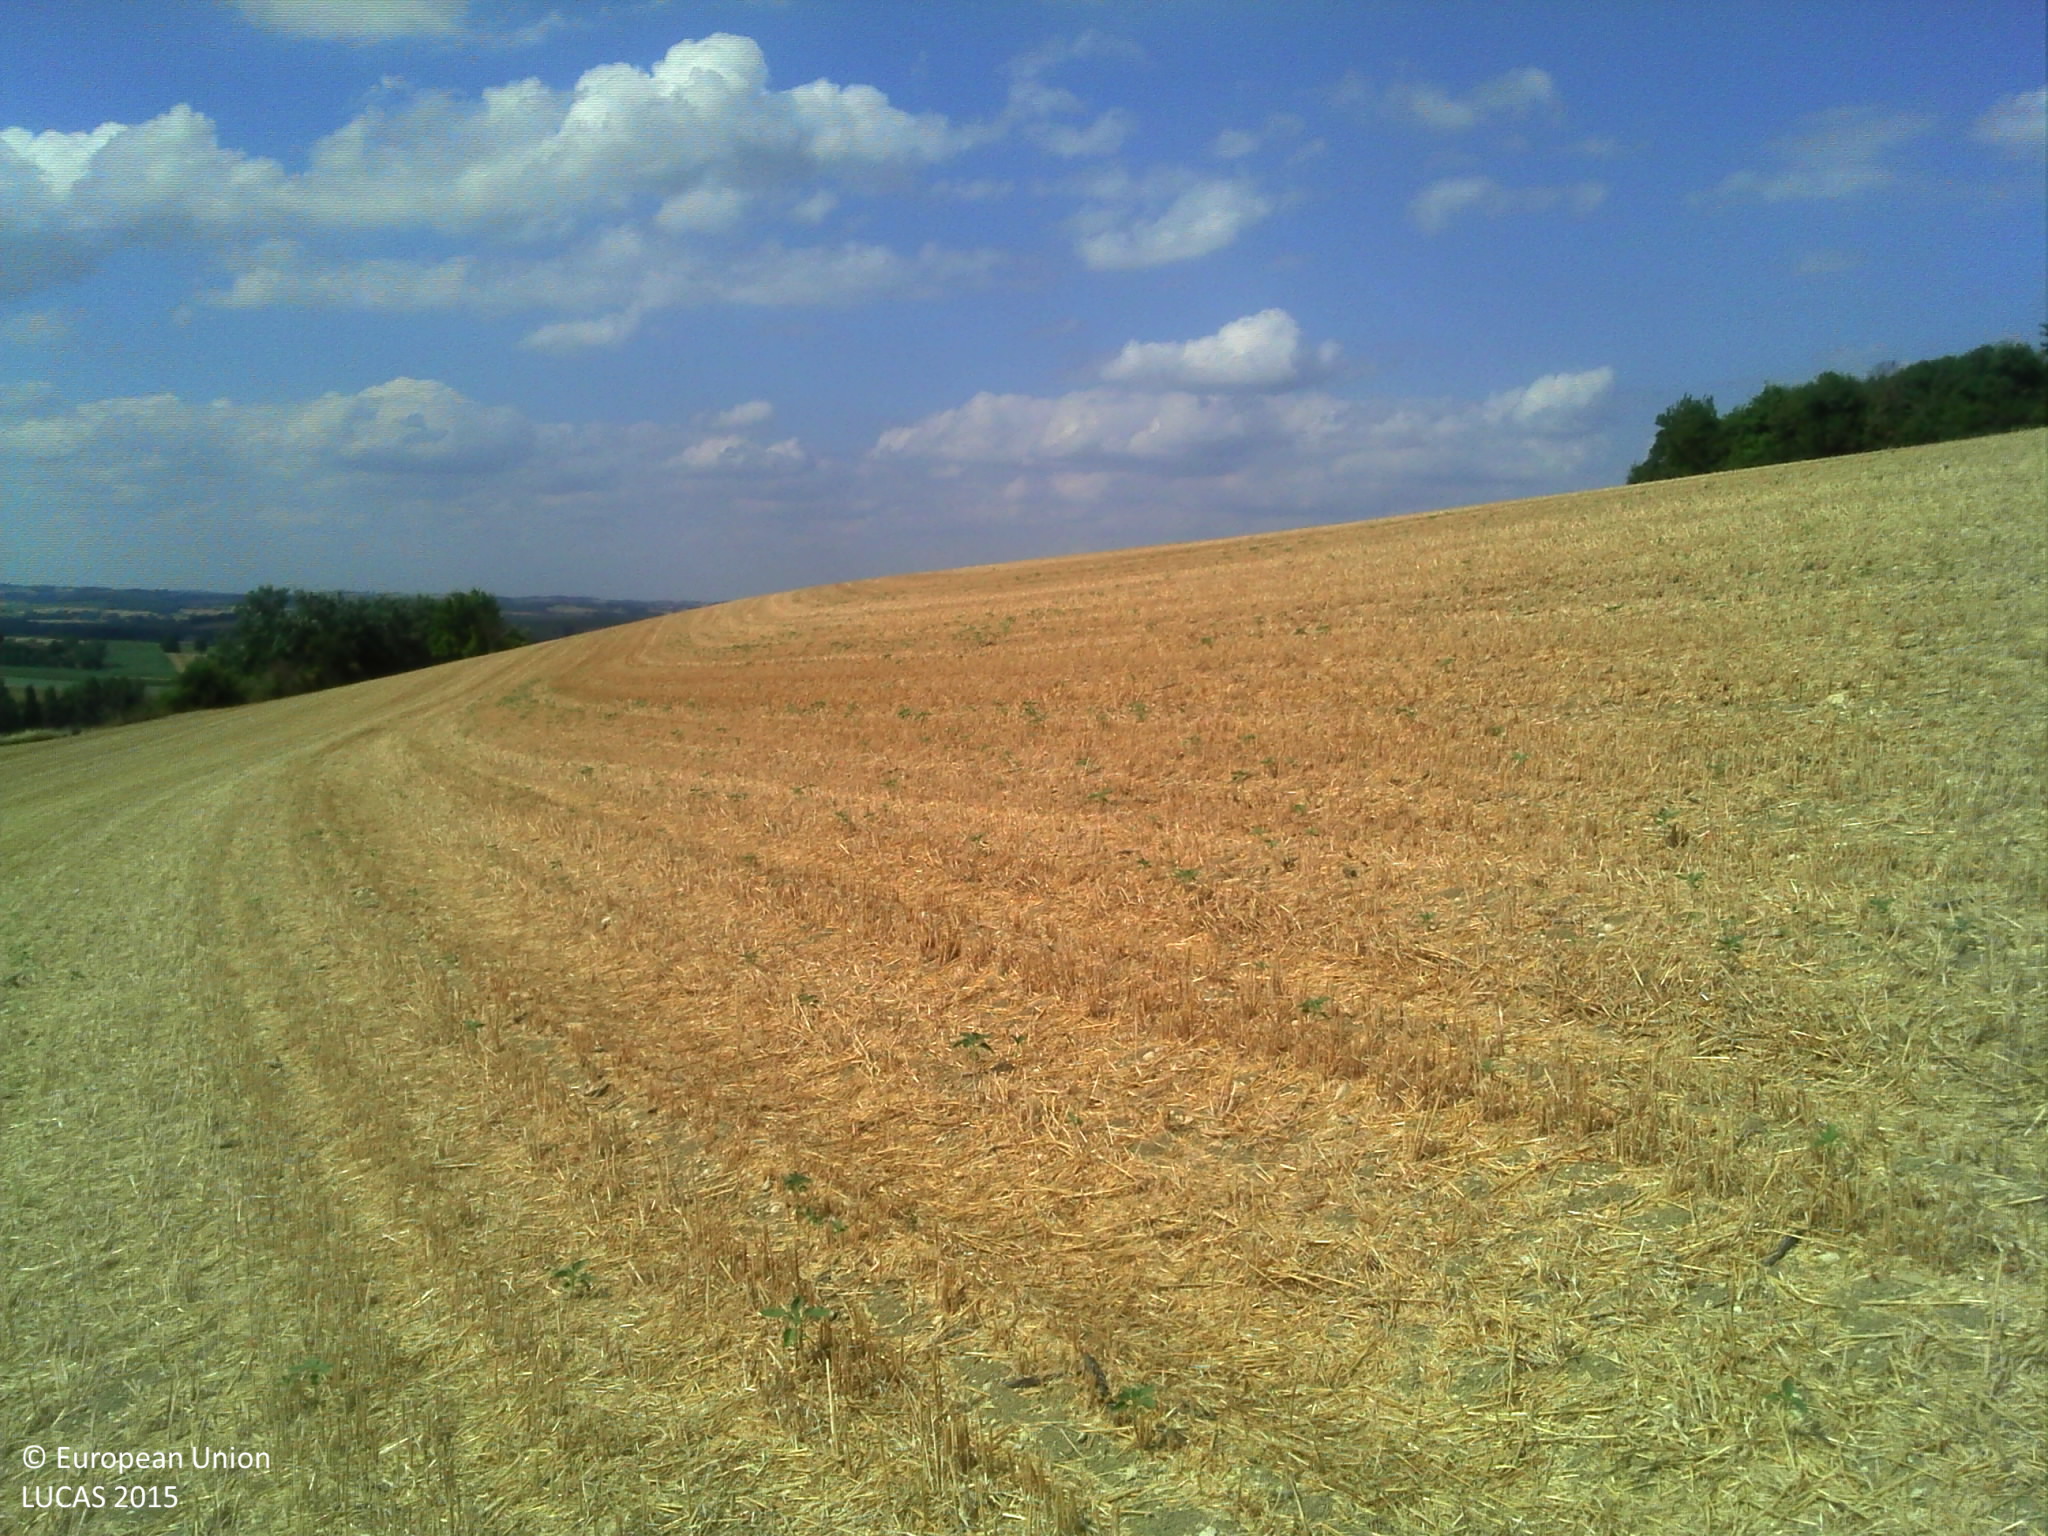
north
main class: Cropland
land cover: Durum wheat
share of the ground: > 75 %
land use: Agriculture (excluding fallow land and kitchen gardens)
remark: Harvested field
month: July
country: FR
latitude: 43.9805
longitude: 0.6335
